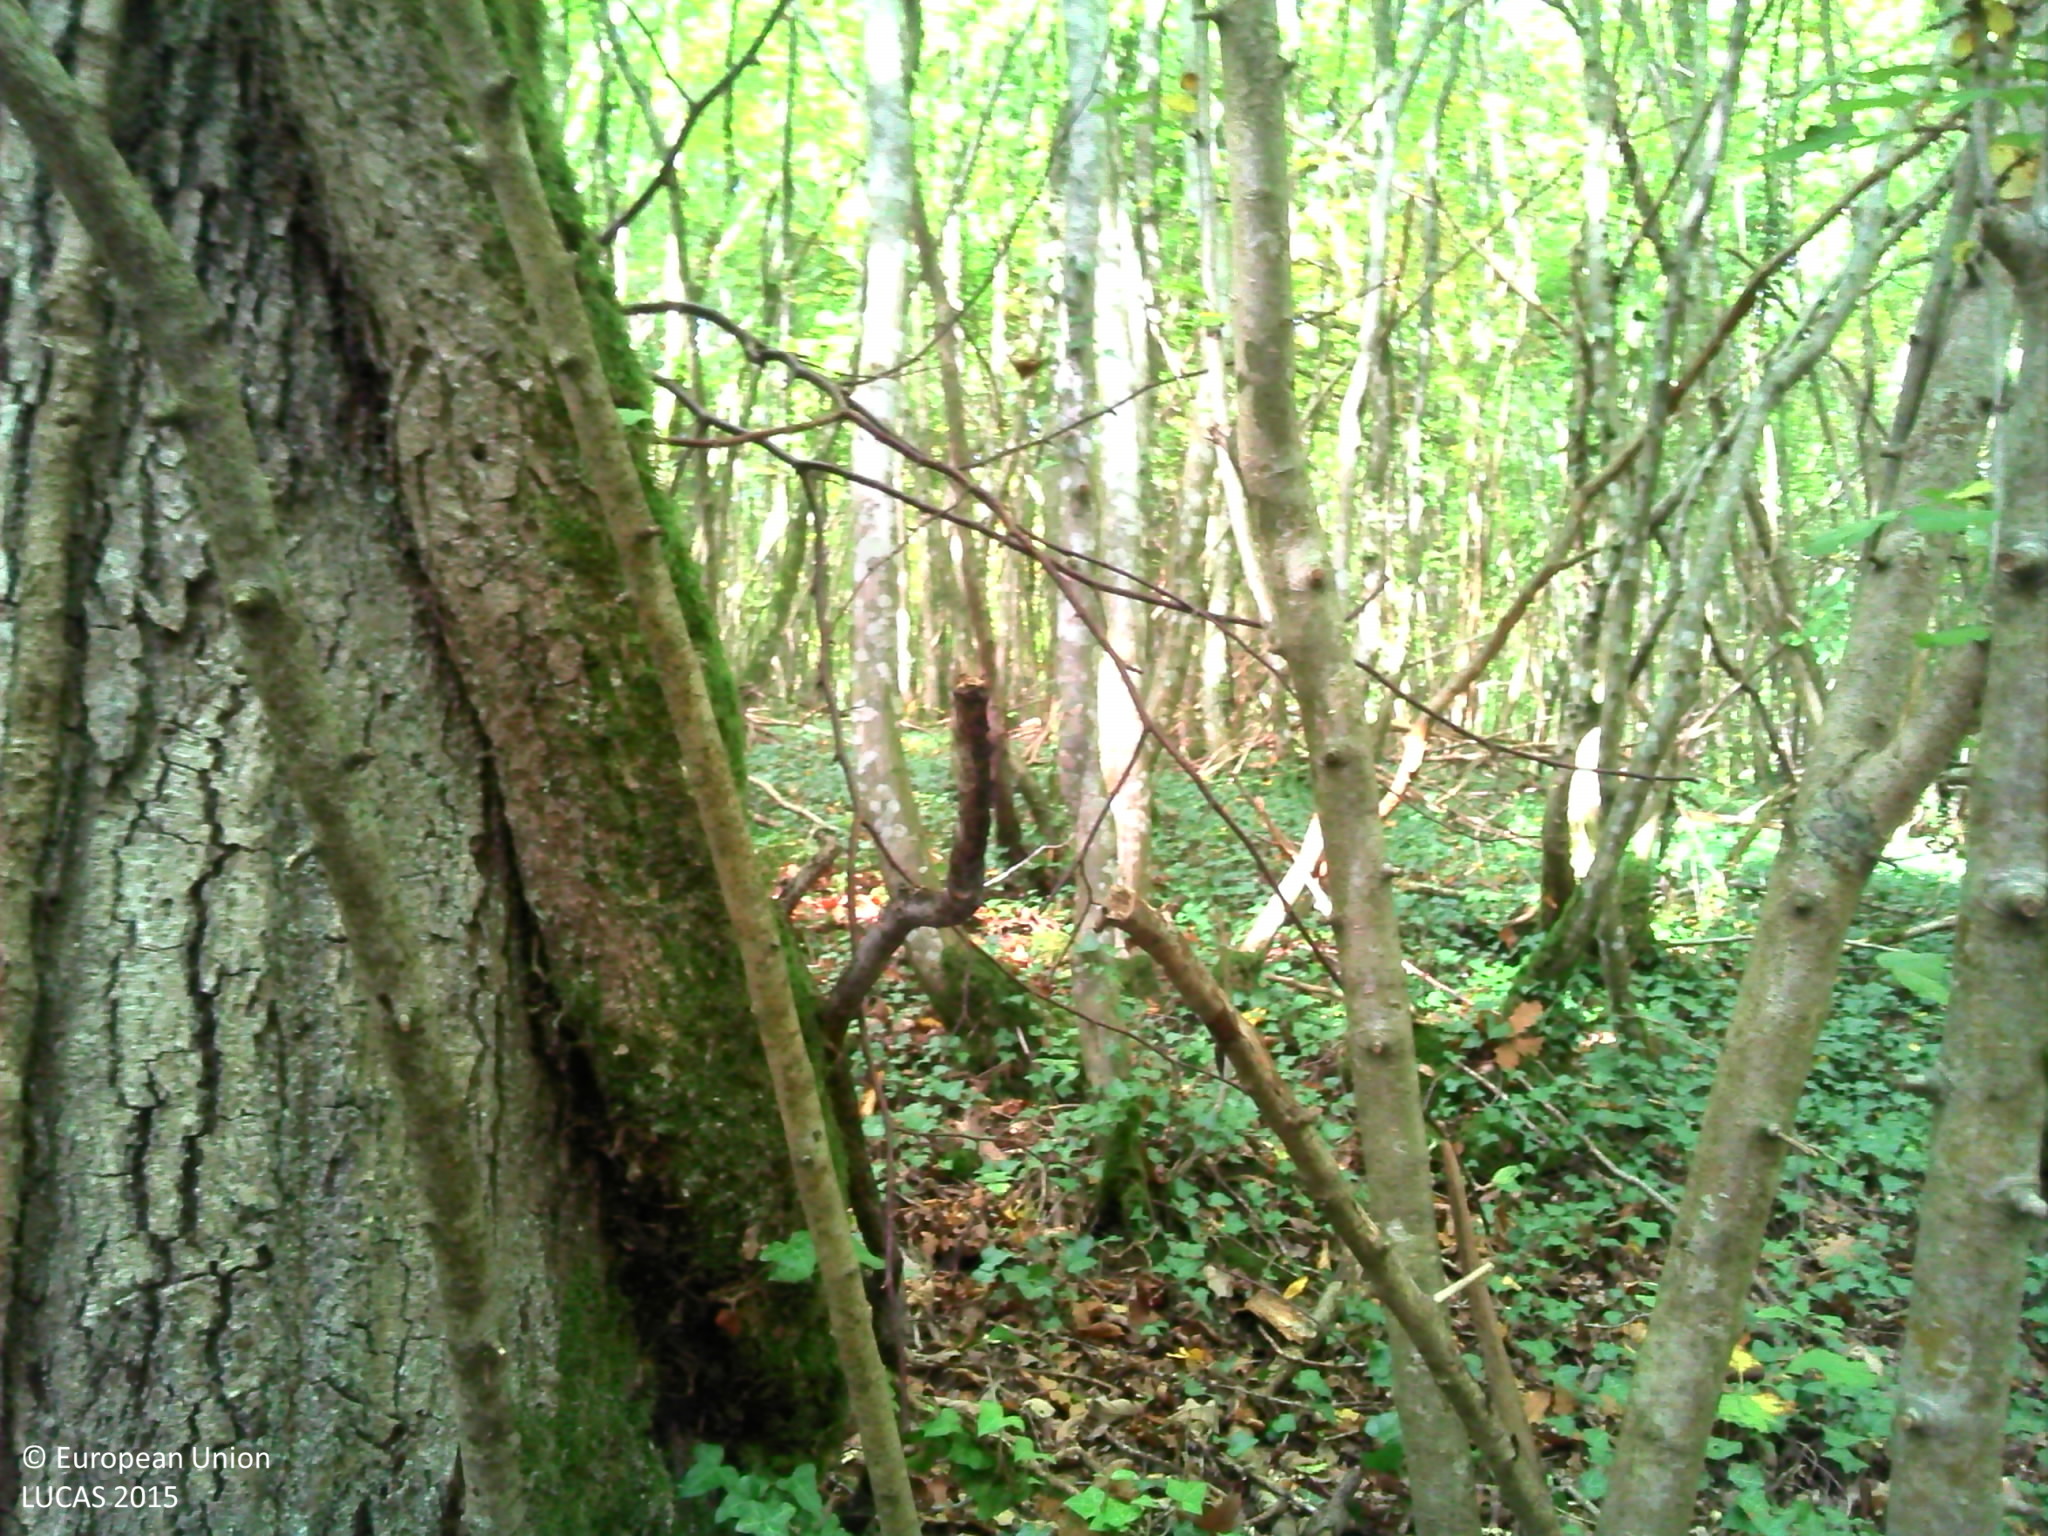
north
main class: Woodland
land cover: Broadleaved woodland
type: mesophytic deciduous forest
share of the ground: > 75 %
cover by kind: broadleaved forest trees 90 %, herbaceous plants 10 %
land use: Forestry
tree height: > 5 m
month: October
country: FR
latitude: 49.6062
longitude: 5.0019
